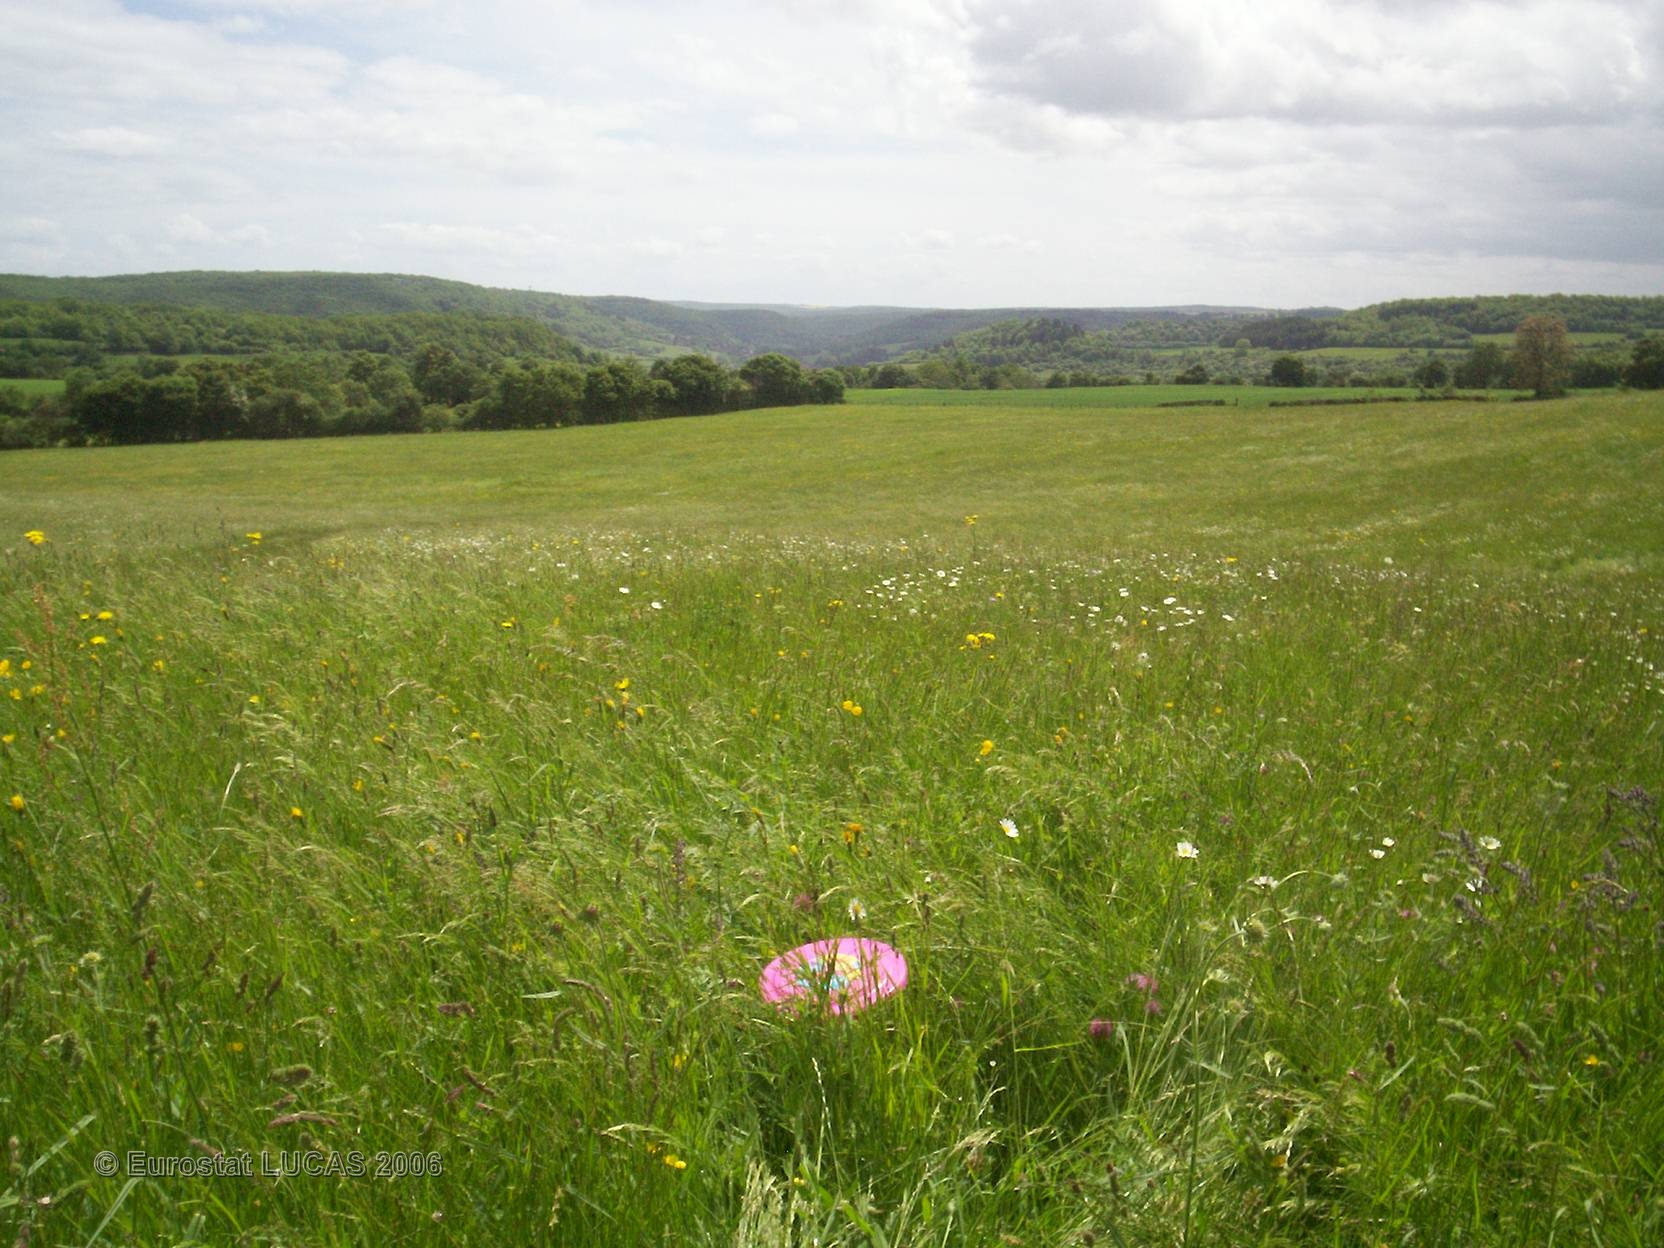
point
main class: Grassland
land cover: Grassland without tree/shrub cover
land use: Agriculture (excluding fallow land and kitchen gardens)
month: May
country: FR
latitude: 47.1382
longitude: 4.6602
